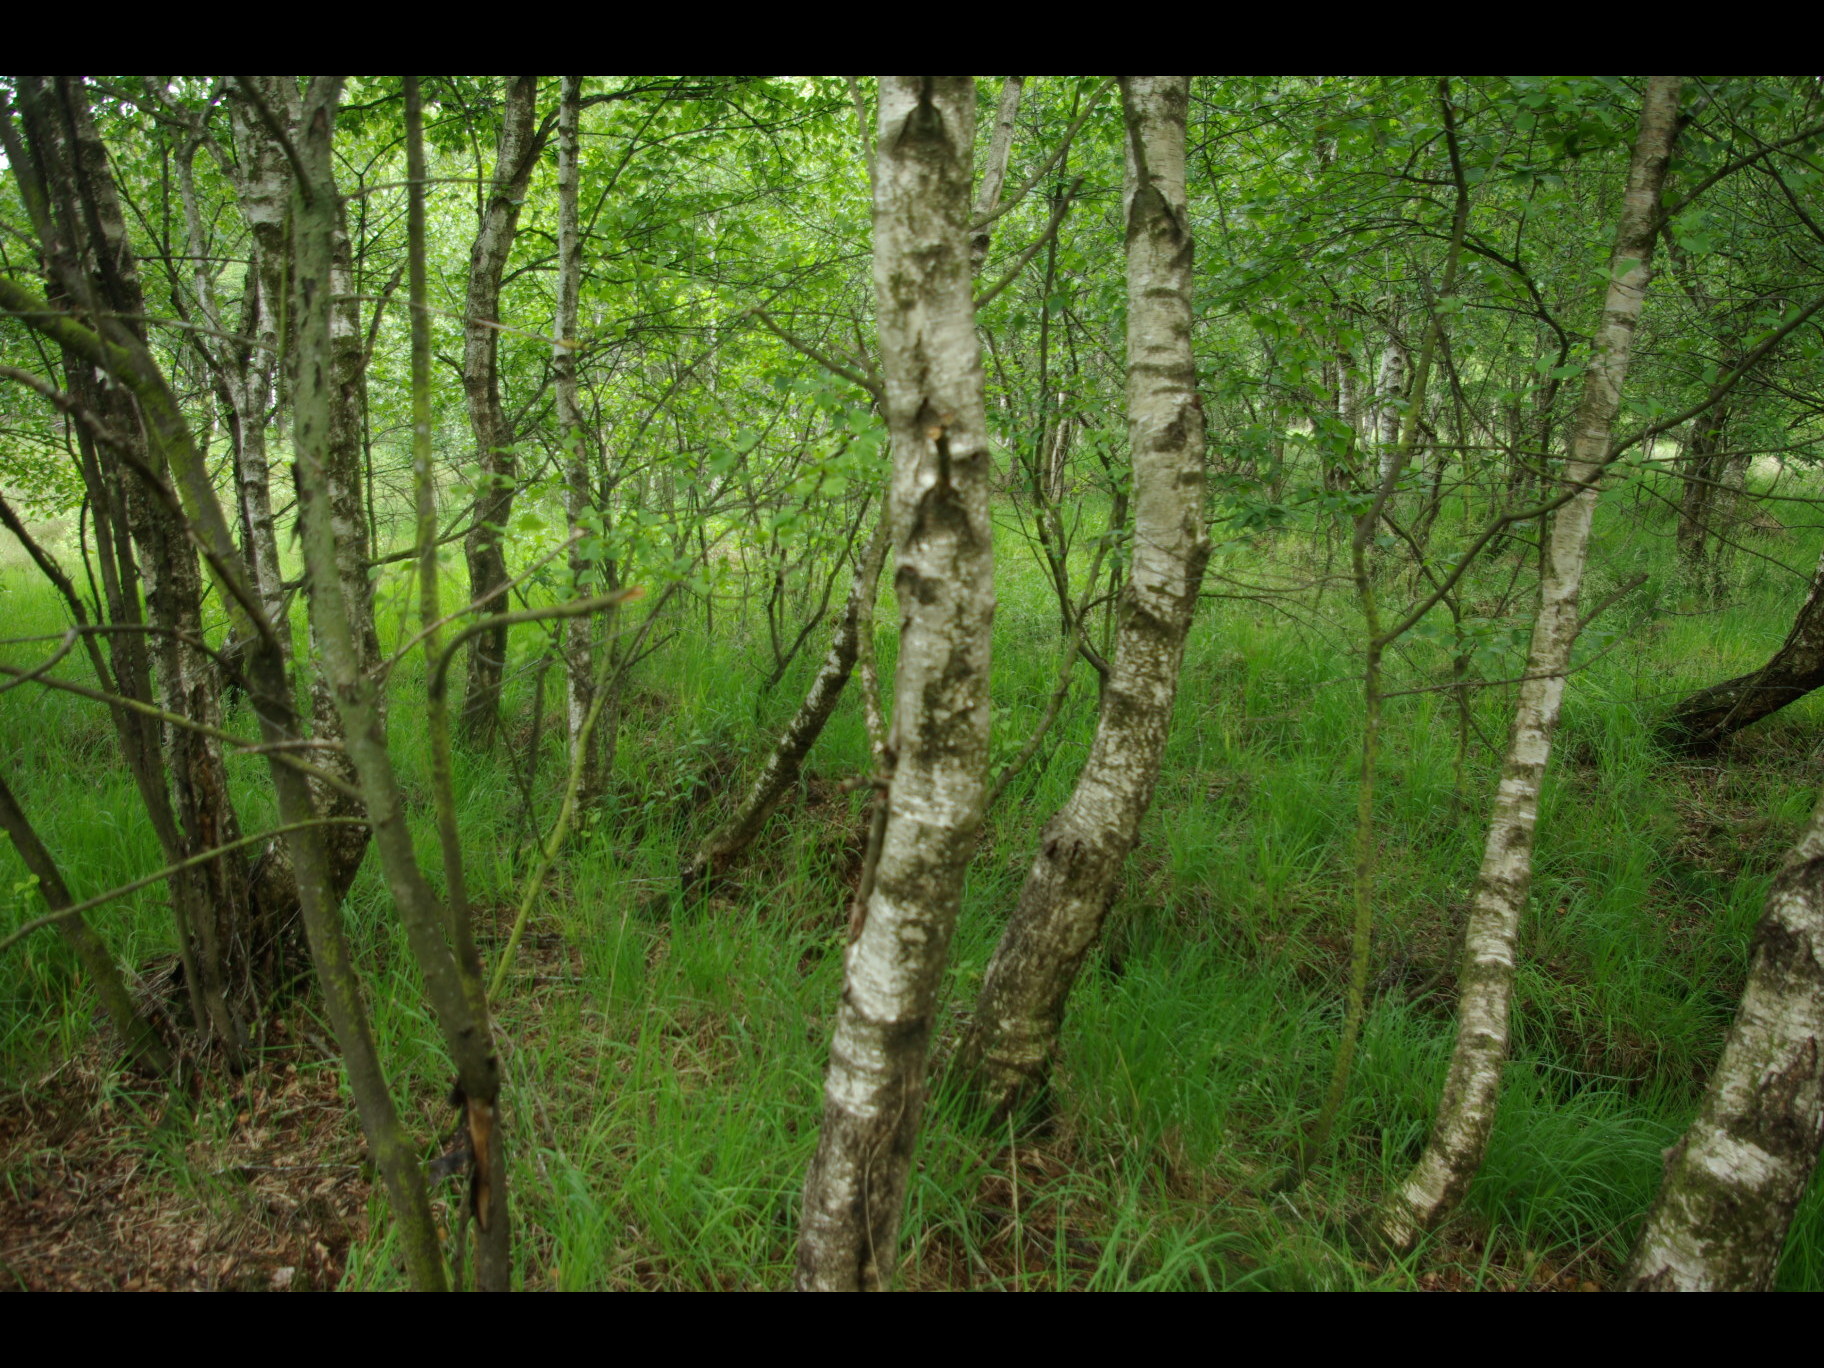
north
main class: Woodland
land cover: Broadleaved woodland
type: mire and swamp forests
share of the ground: > 75 %
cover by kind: broadleaved forest trees 70 %, herbaceous plants 20 %, lichens and mosses 10 %
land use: Semi-natural and natural areas not in use
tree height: < 5 m
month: June
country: DE
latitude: 54.1567
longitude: 9.9541
